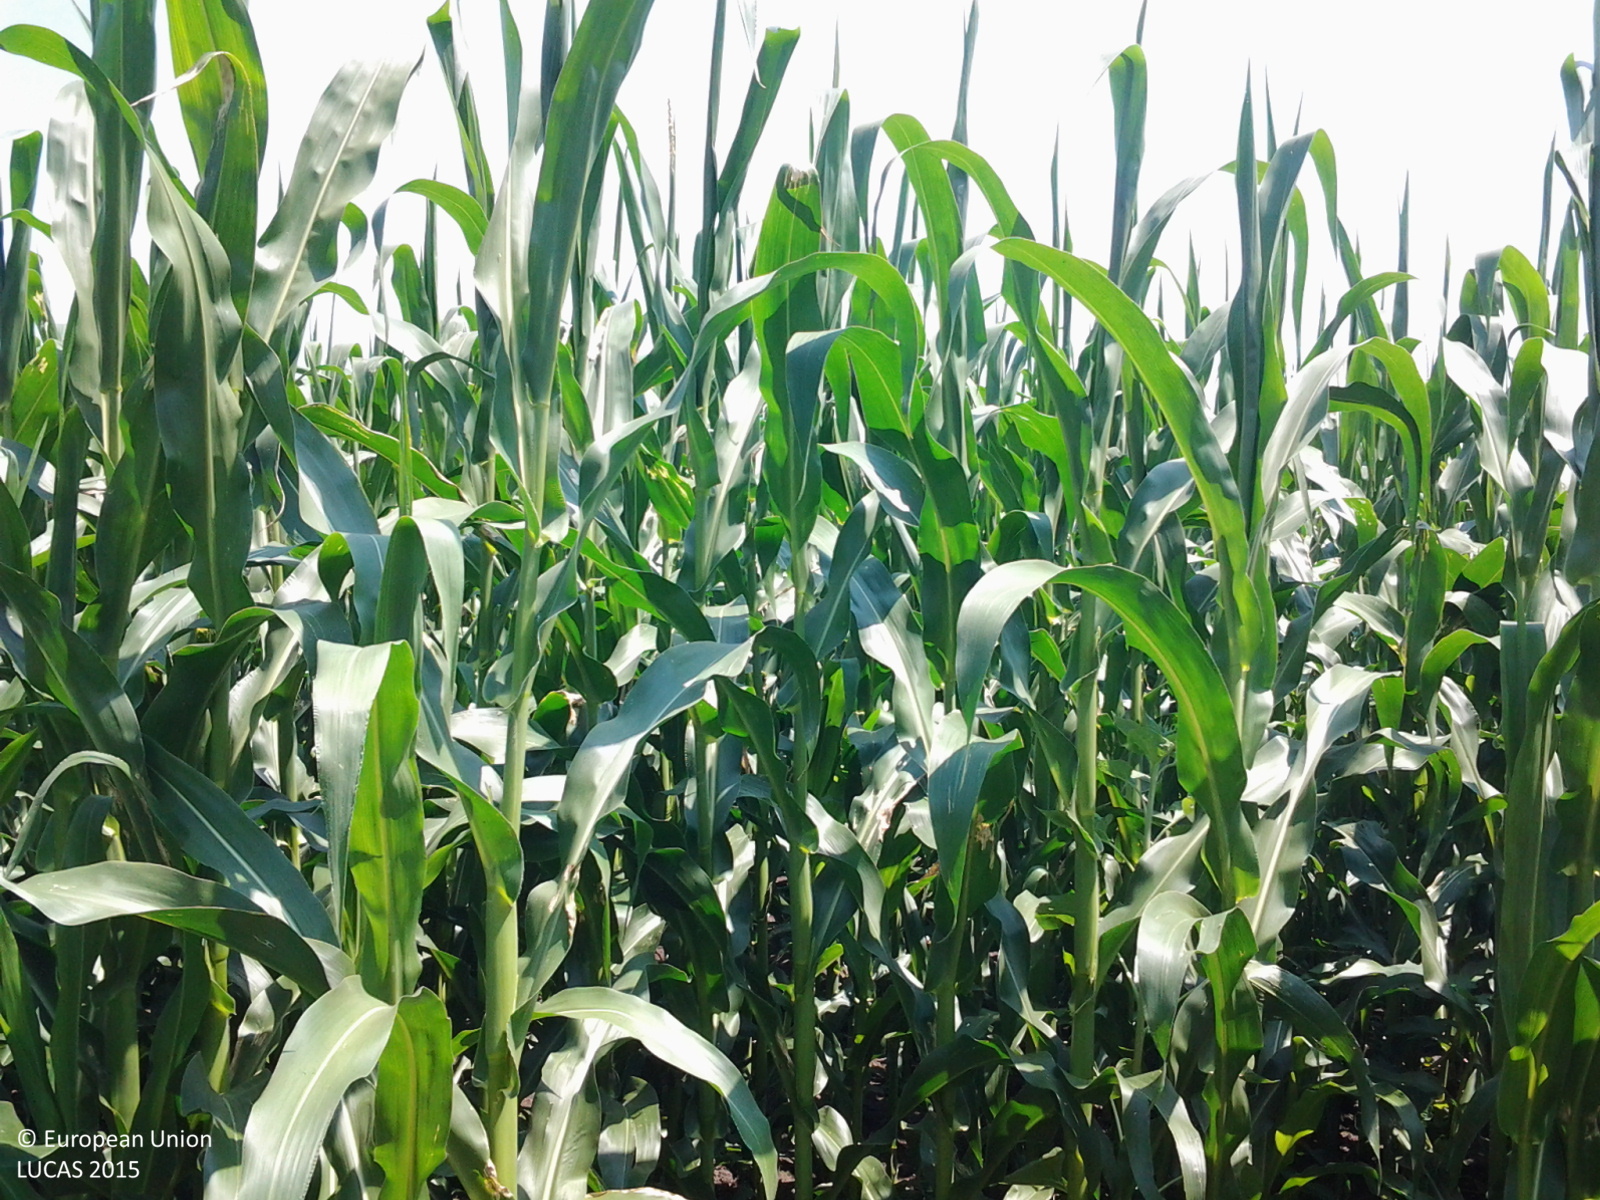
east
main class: Cropland
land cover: Maize
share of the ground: > 75 %
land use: Agriculture (excluding fallow land and kitchen gardens)
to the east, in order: Maize
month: July
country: HU
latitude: 47.5285
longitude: 19.8403
